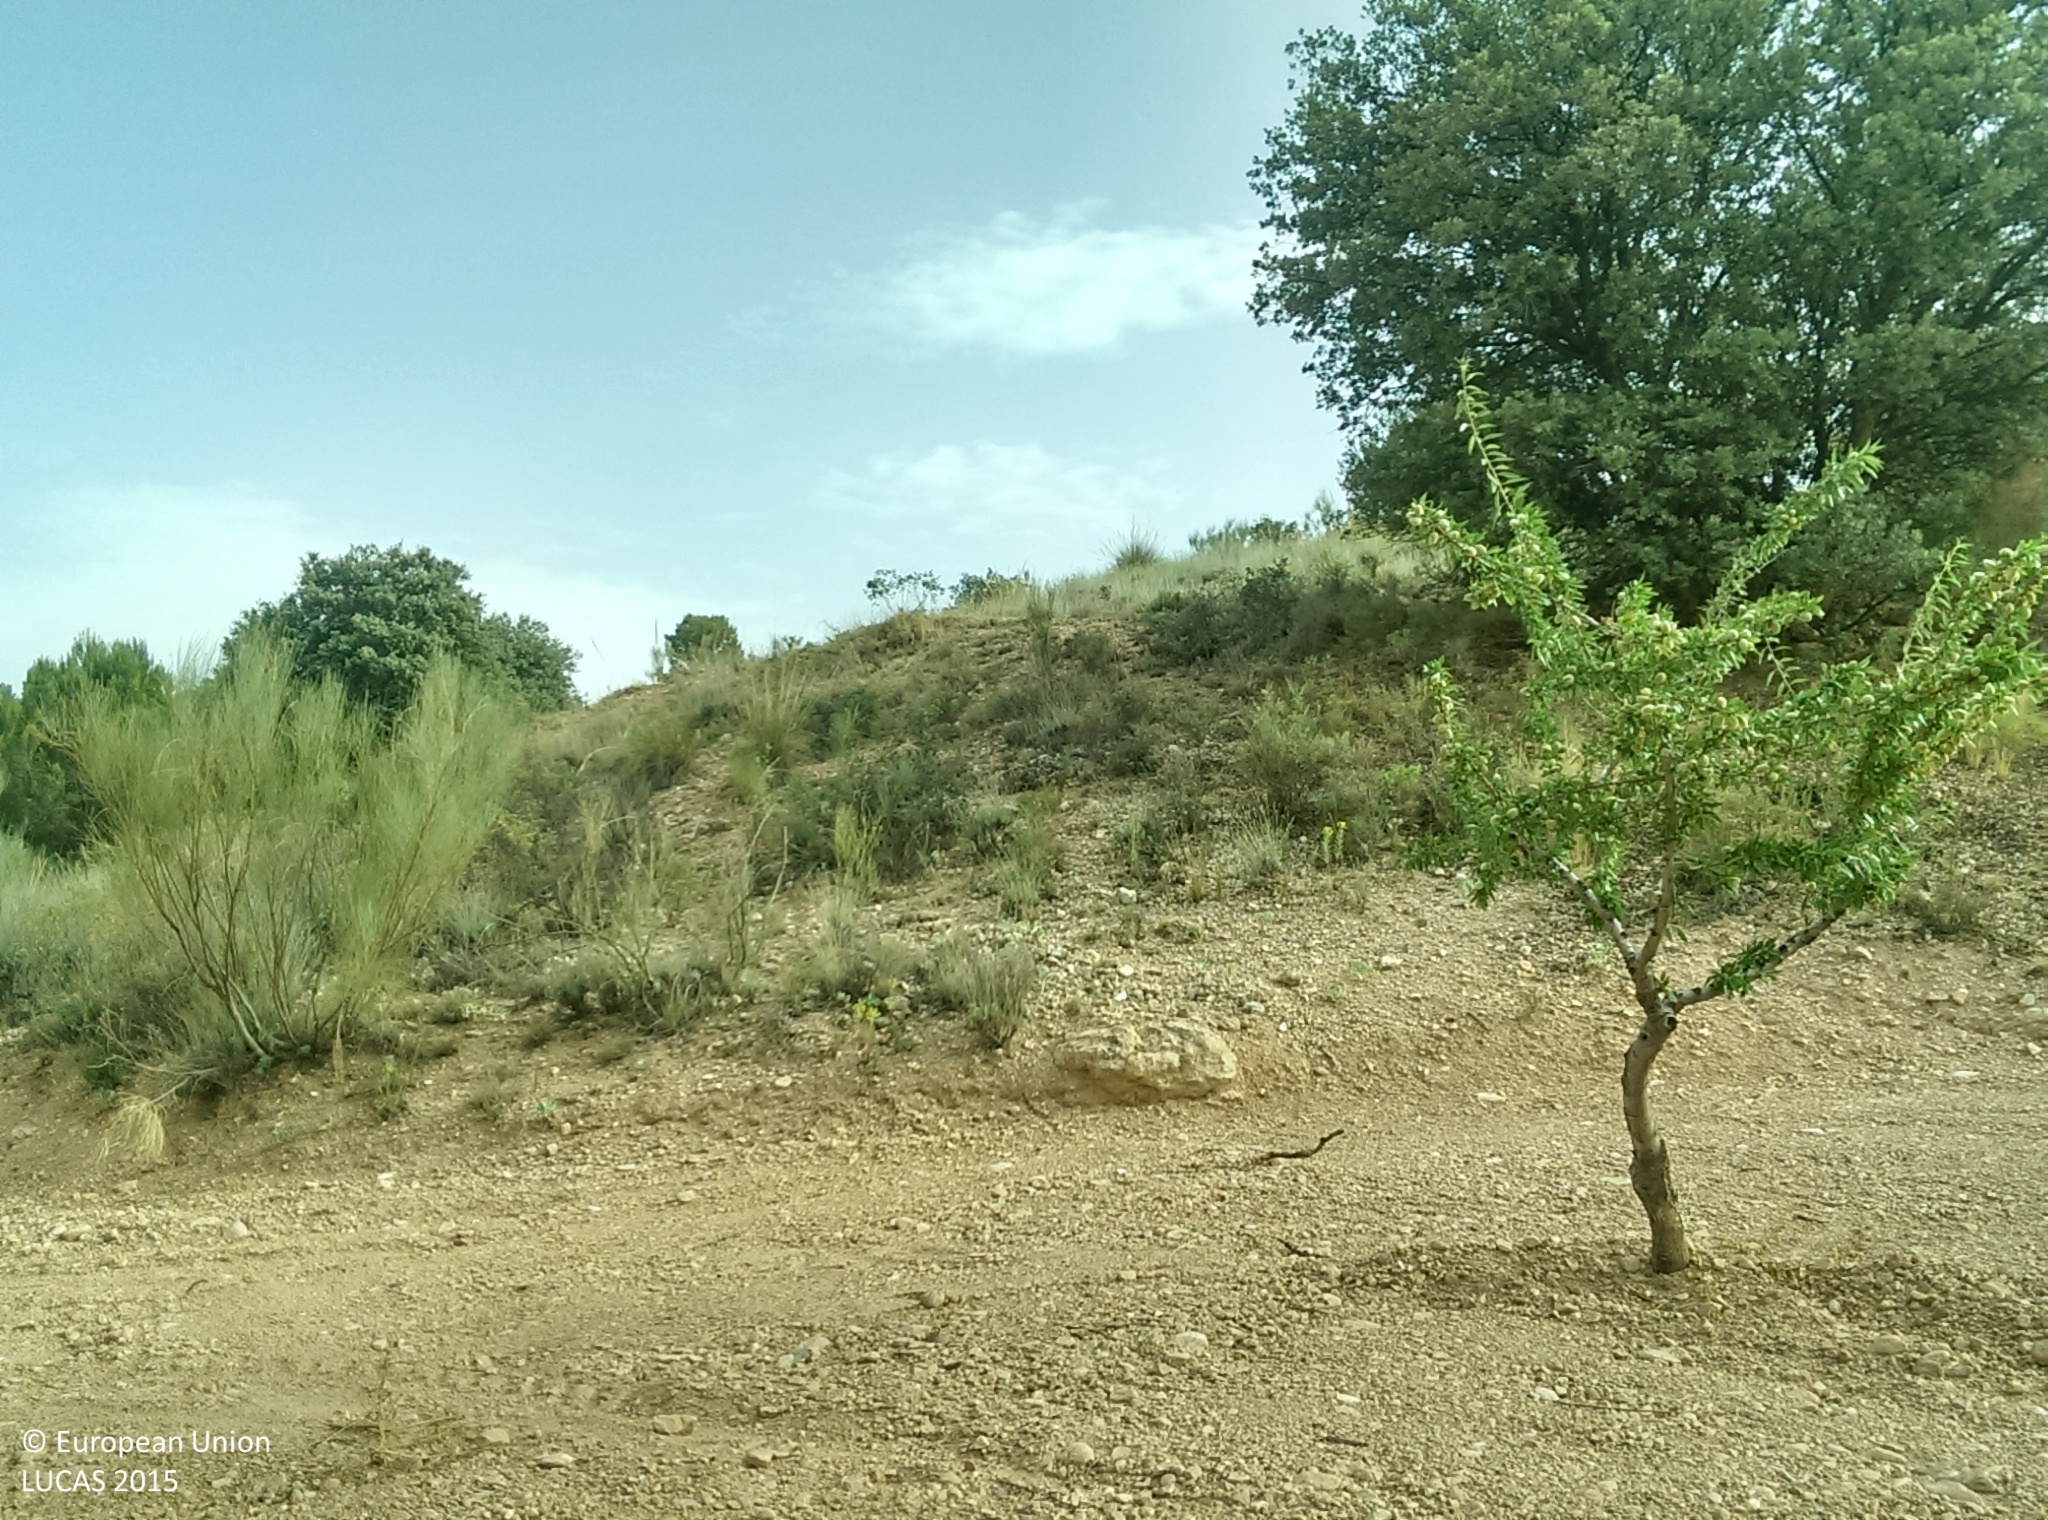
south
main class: Cropland
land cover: Nuts trees
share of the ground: 25 - 50 %
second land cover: Other bare soil
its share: > 75 %
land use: Agriculture (excluding fallow land and kitchen gardens)
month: July
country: ES
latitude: 37.4895
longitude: -2.8926
